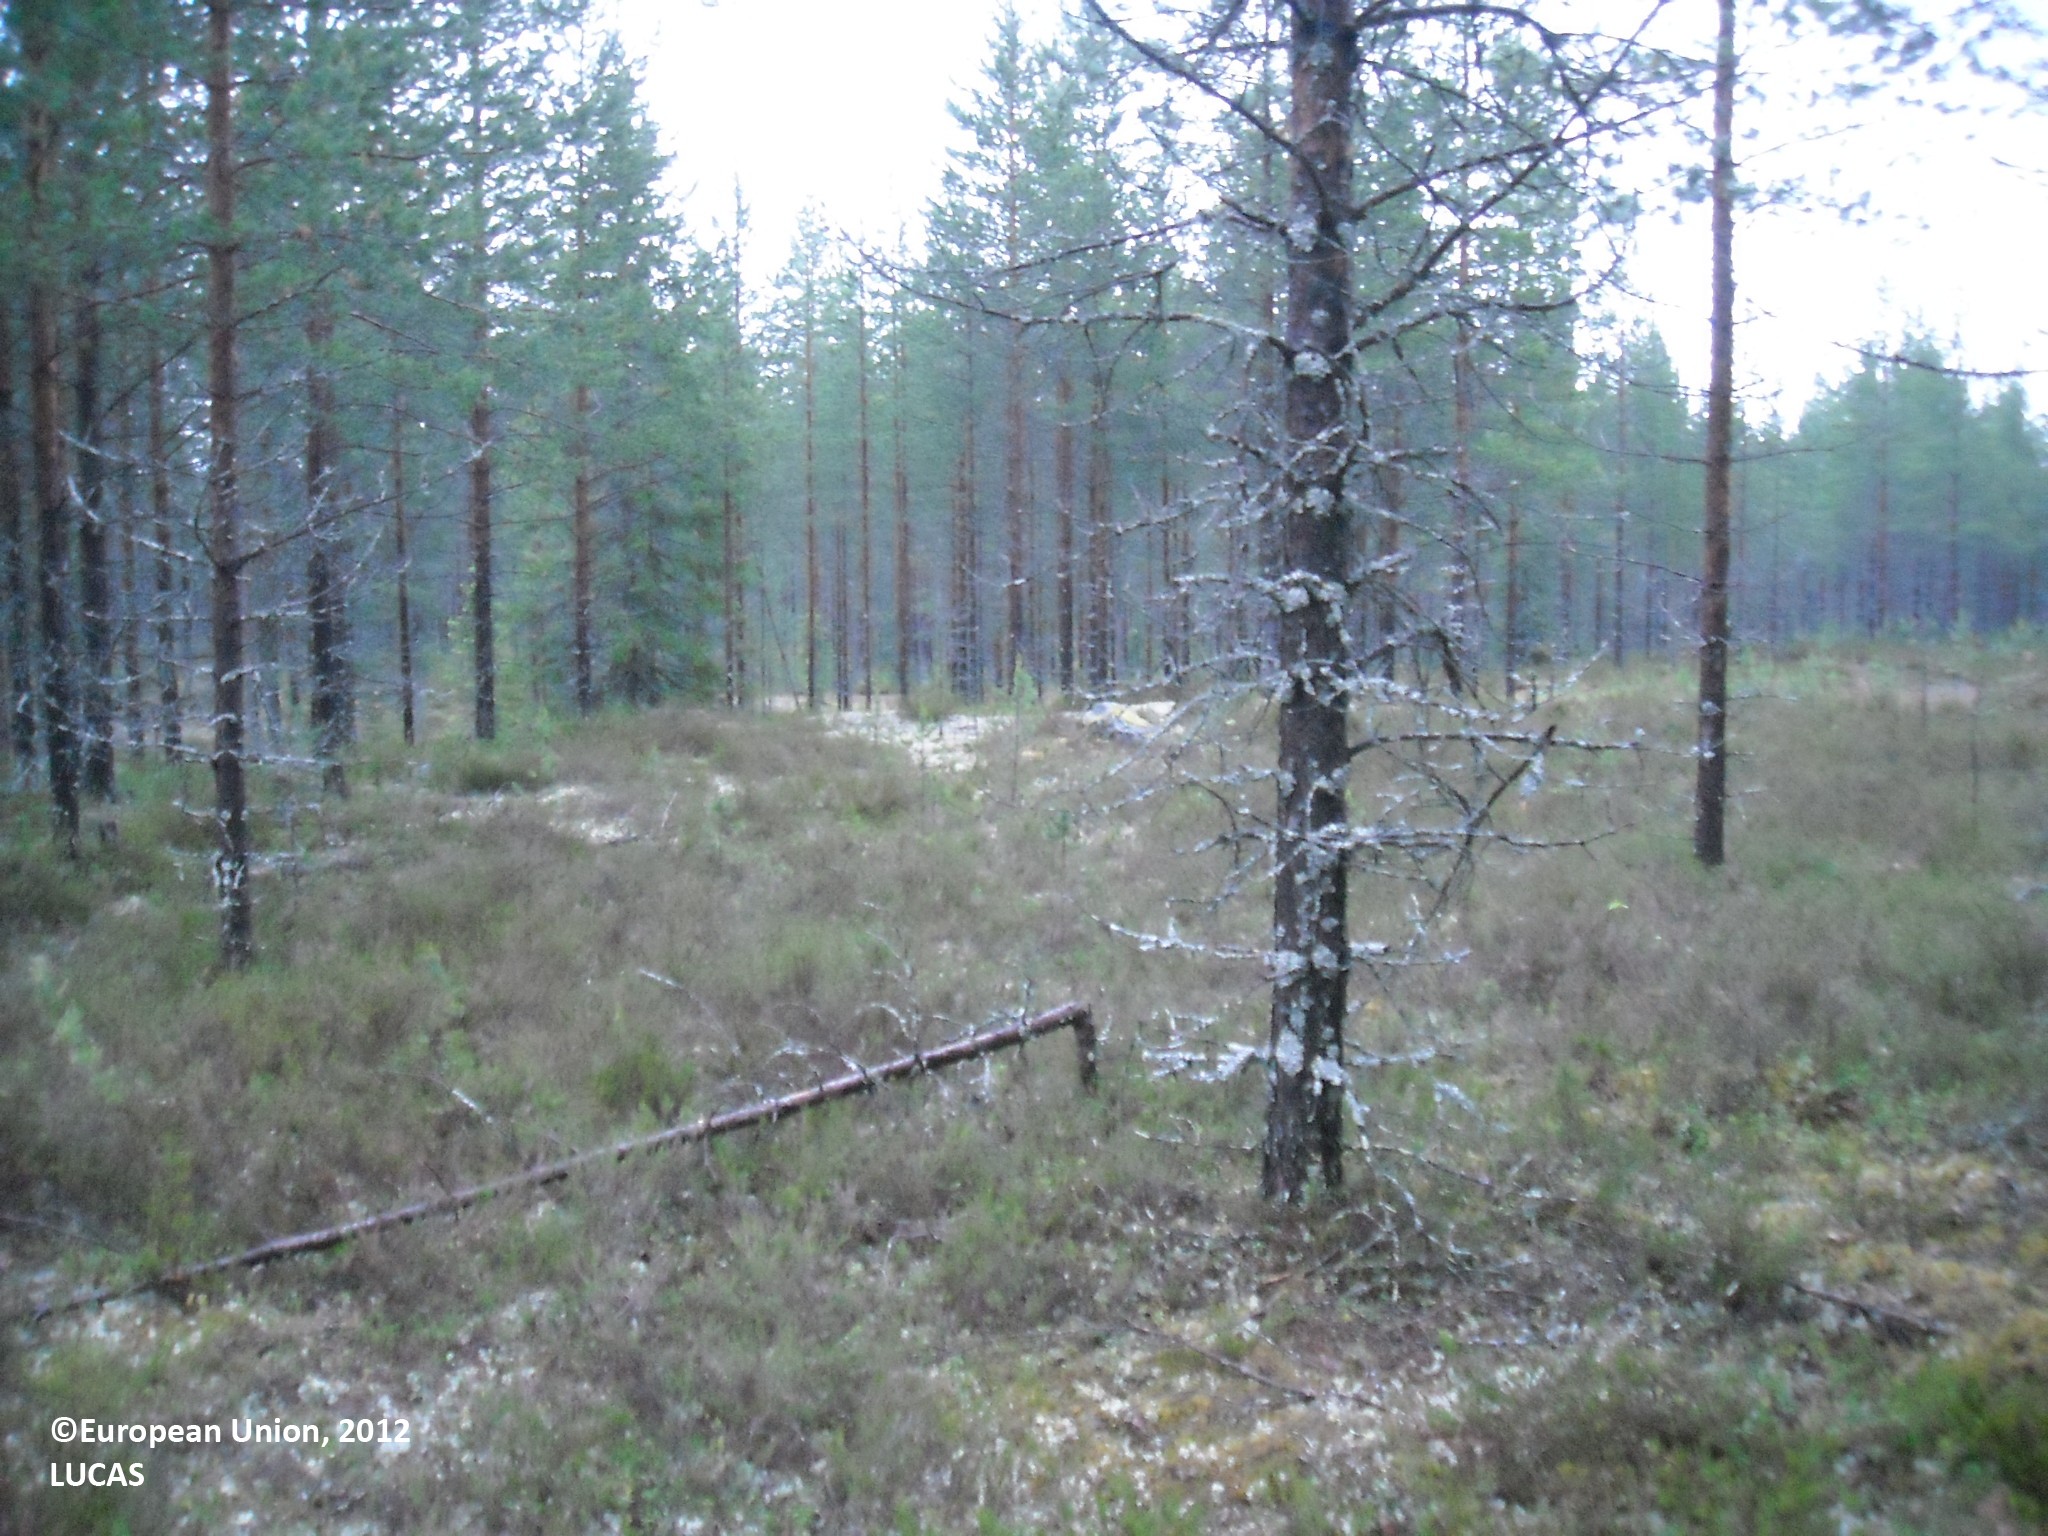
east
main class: Woodland
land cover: Pine dominated coniferous woodland
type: boreal forest
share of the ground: 25 - 50 %
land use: Forestry
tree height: > 5 m
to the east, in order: Pine dominated coniferous woodland; Paved roads, cycling and walking lanes; Pine dominated coniferous woodland
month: July
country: FI
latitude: 64.9883
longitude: 28.0662
